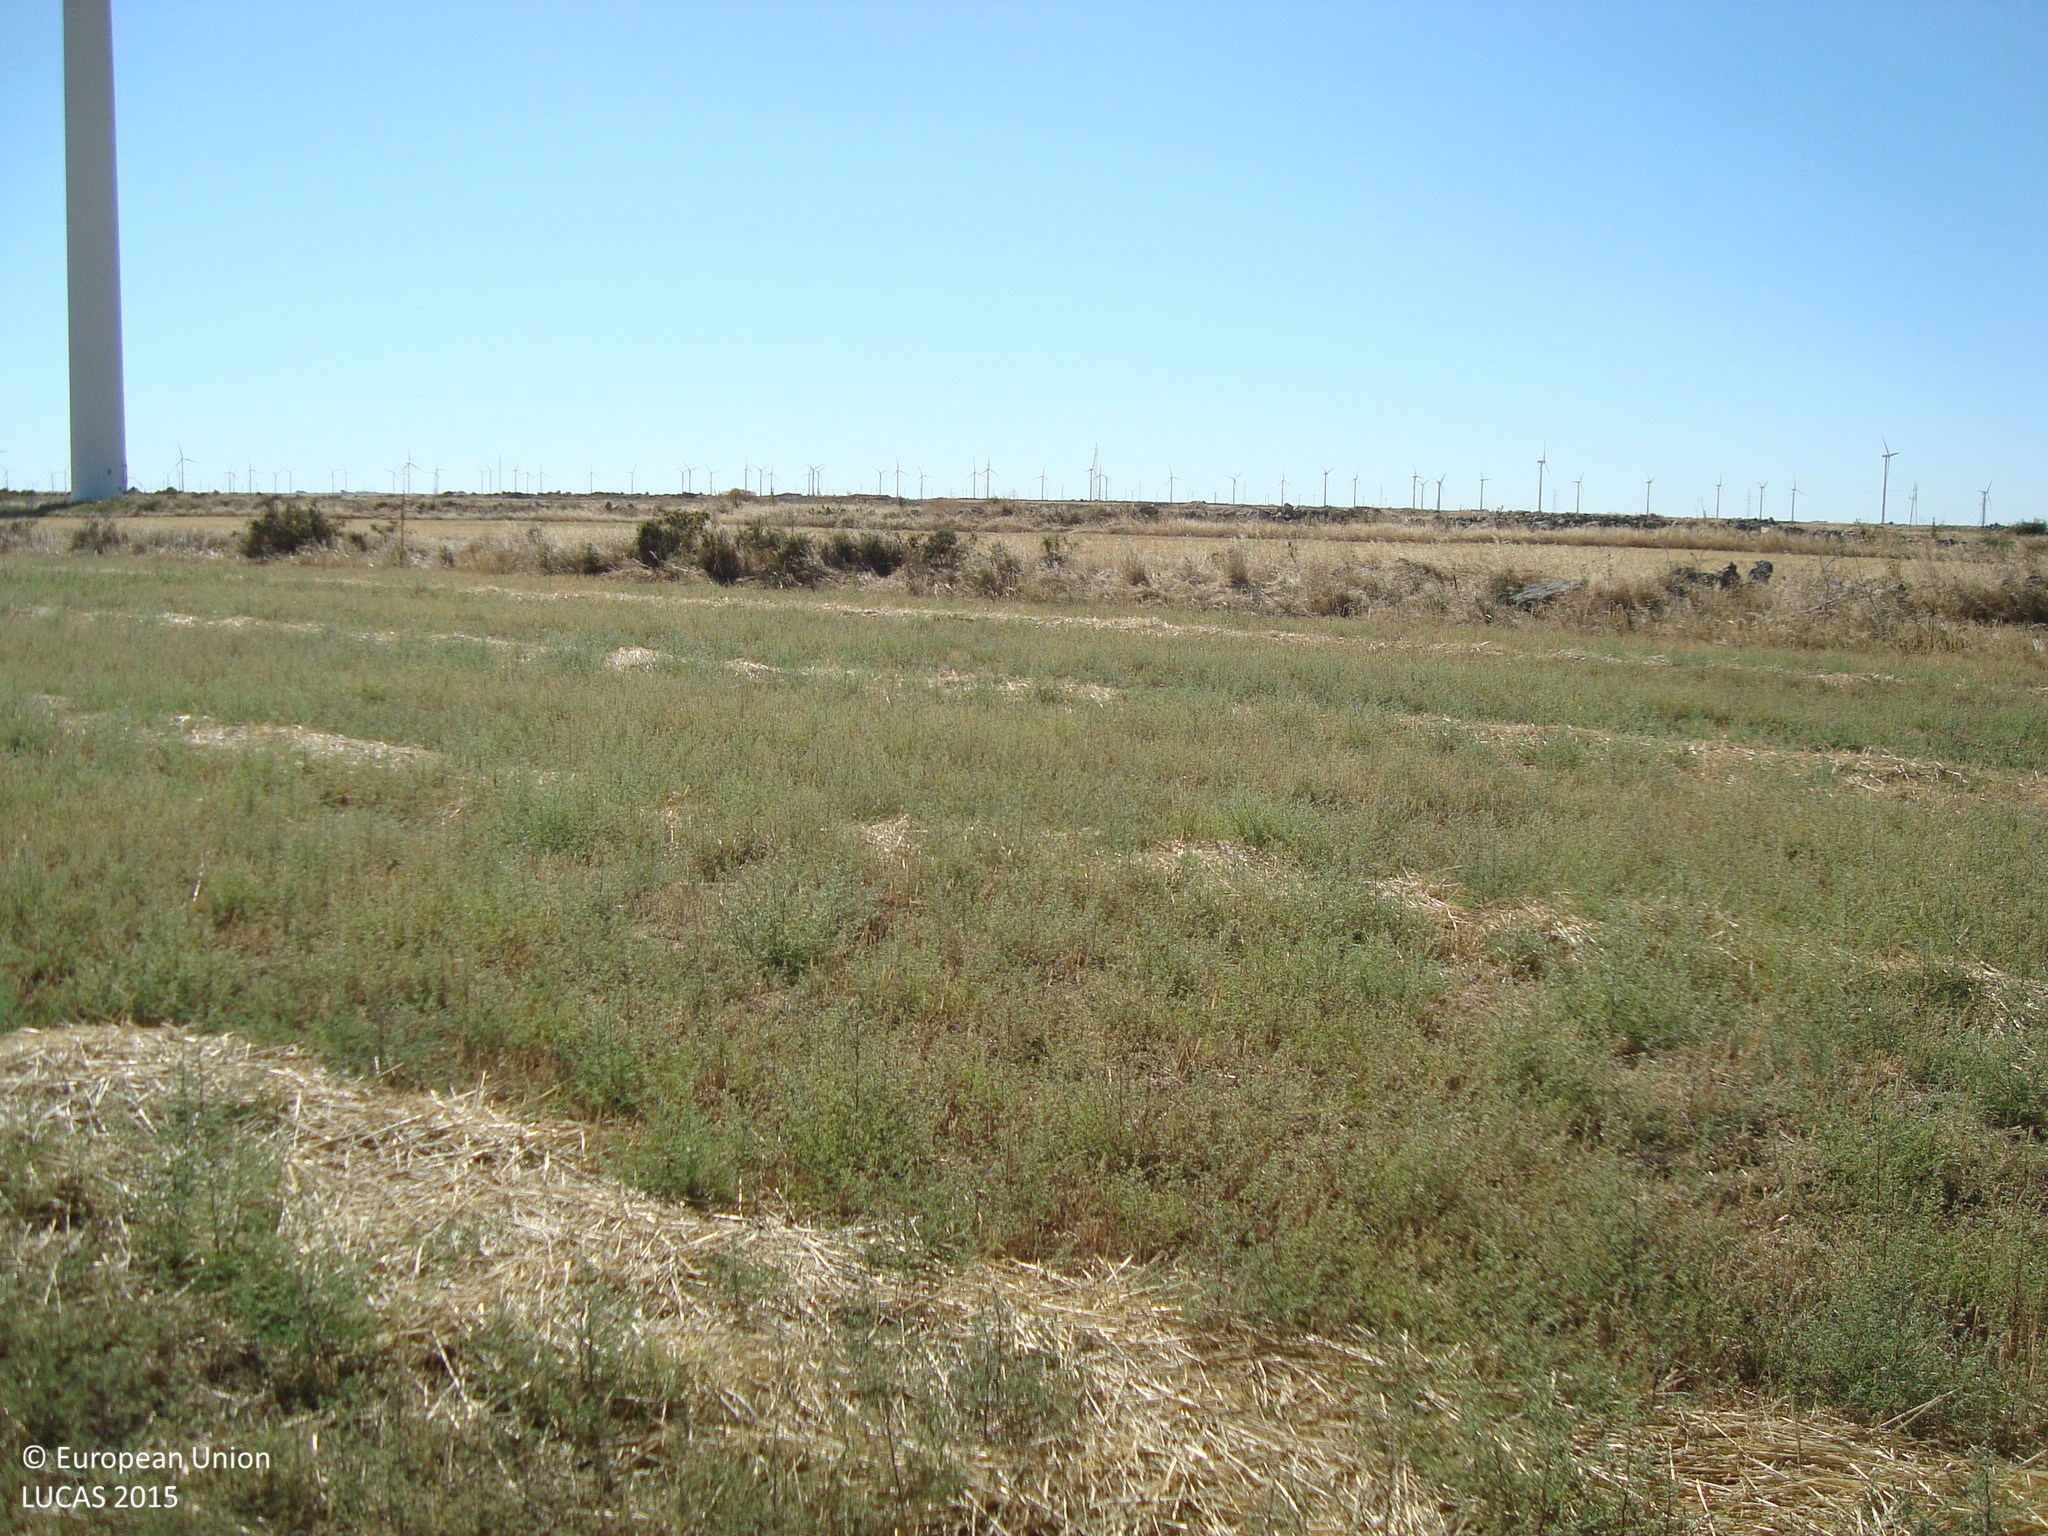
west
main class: Cropland
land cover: Barley
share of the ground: > 75 %
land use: Agriculture (excluding fallow land and kitchen gardens)
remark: Harvested field
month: August
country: ES
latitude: 42.2216
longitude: -4.1560
